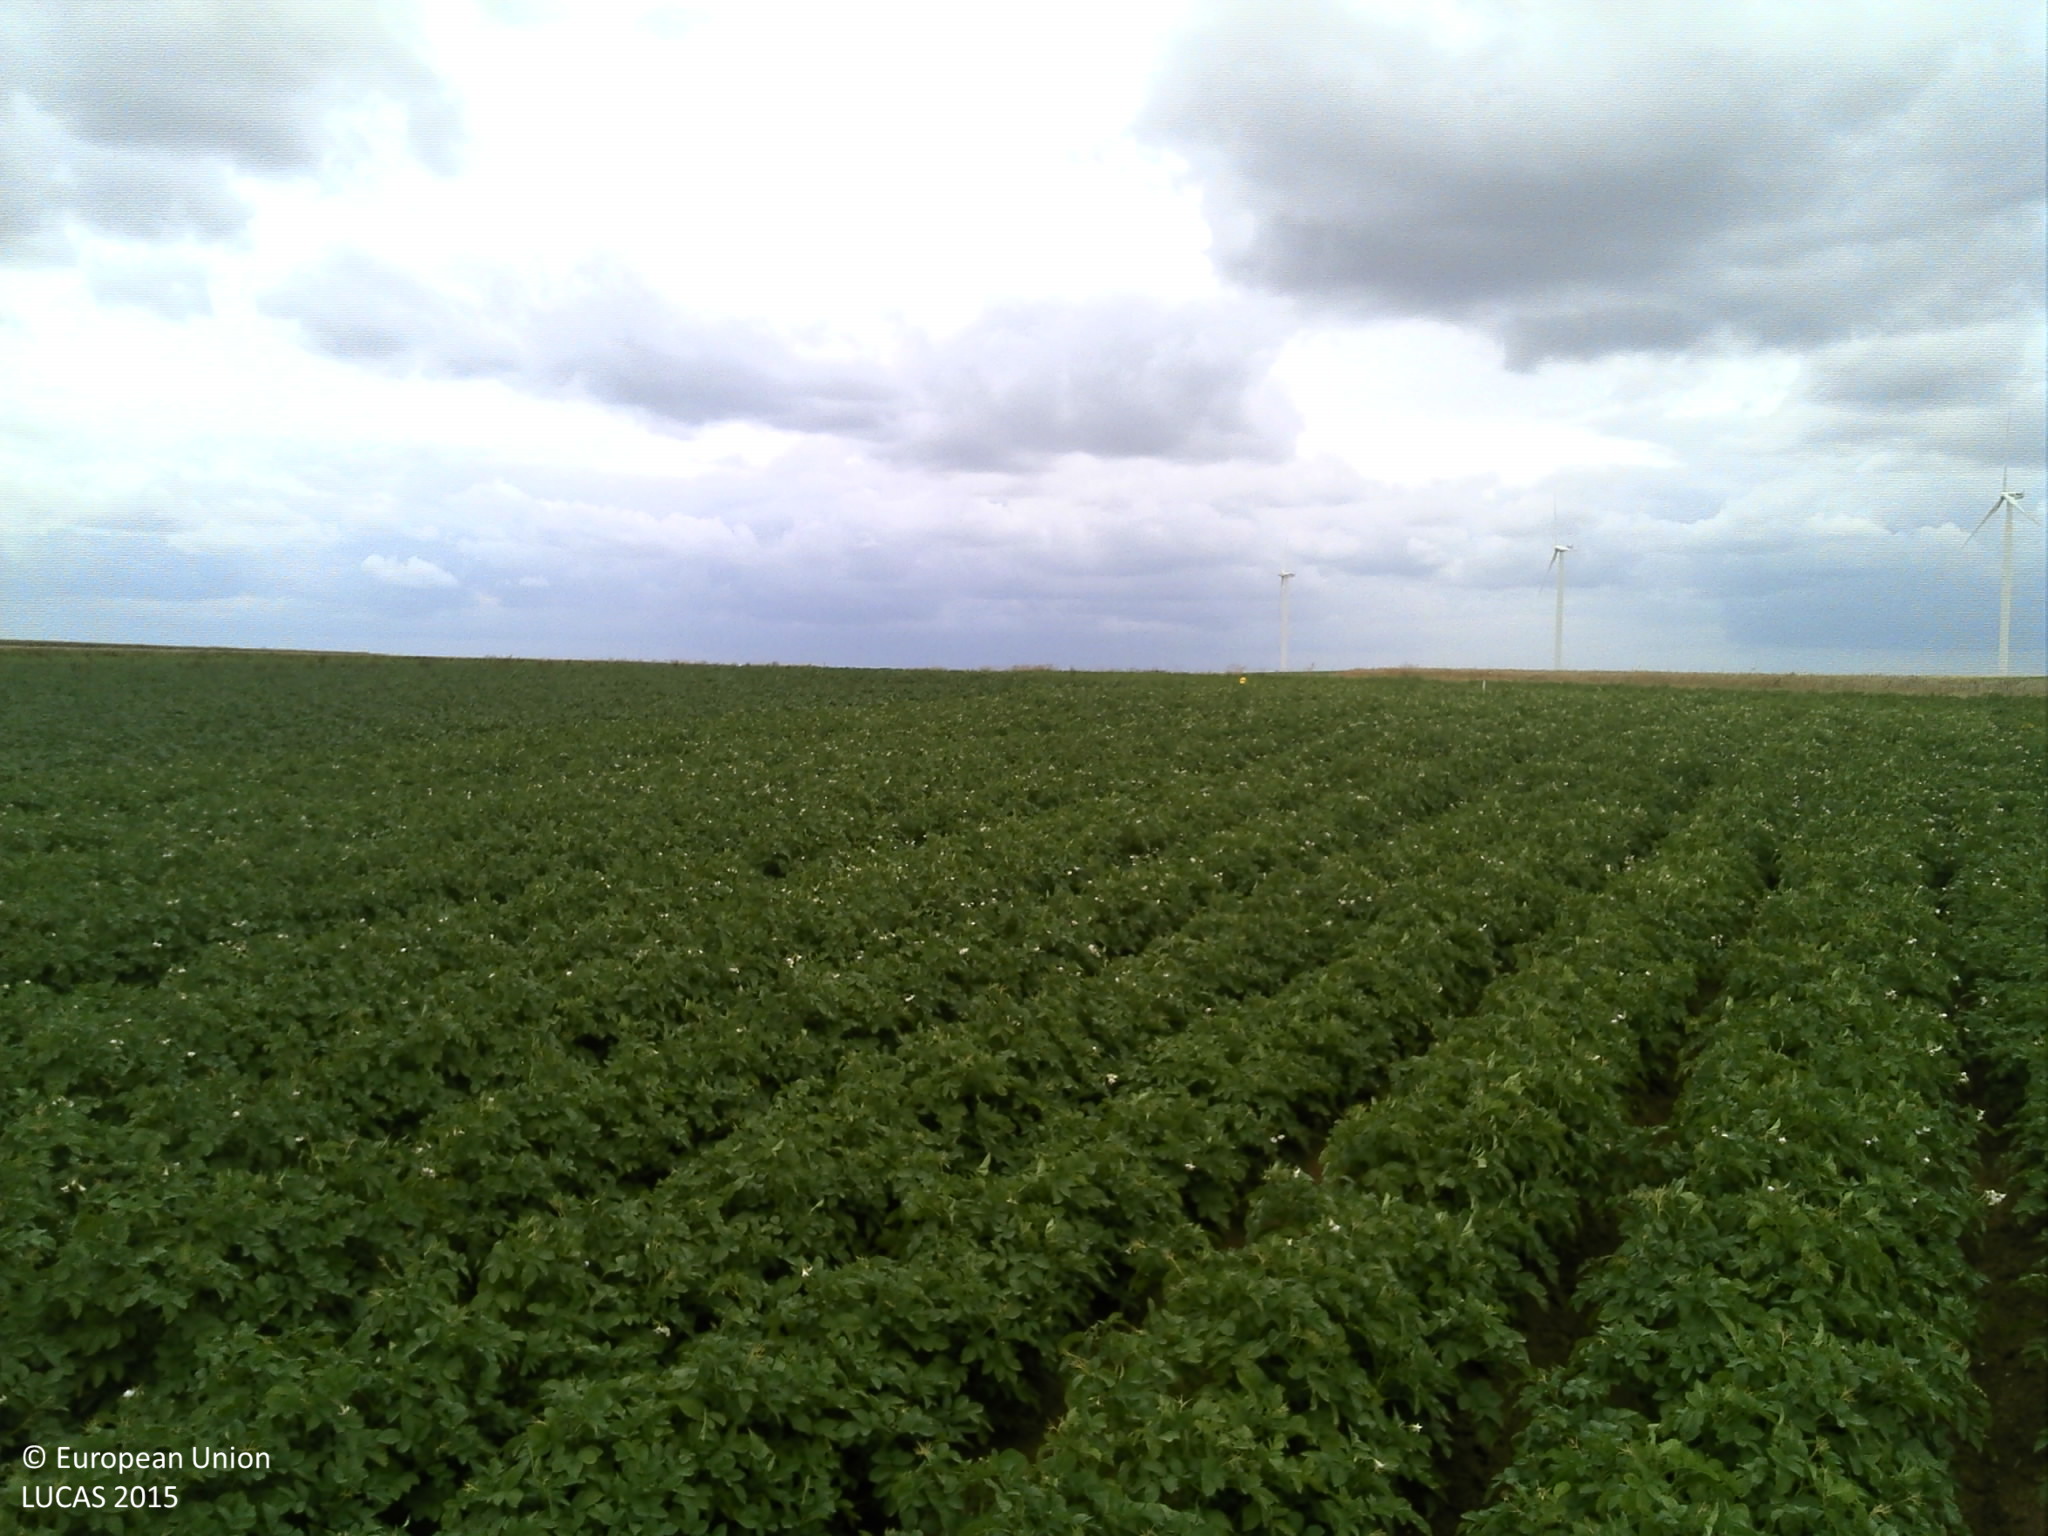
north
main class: Cropland
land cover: Potatoes
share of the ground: > 75 %
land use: Agriculture (excluding fallow land and kitchen gardens)
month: July
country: FR
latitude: 49.6145
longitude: 4.0573
